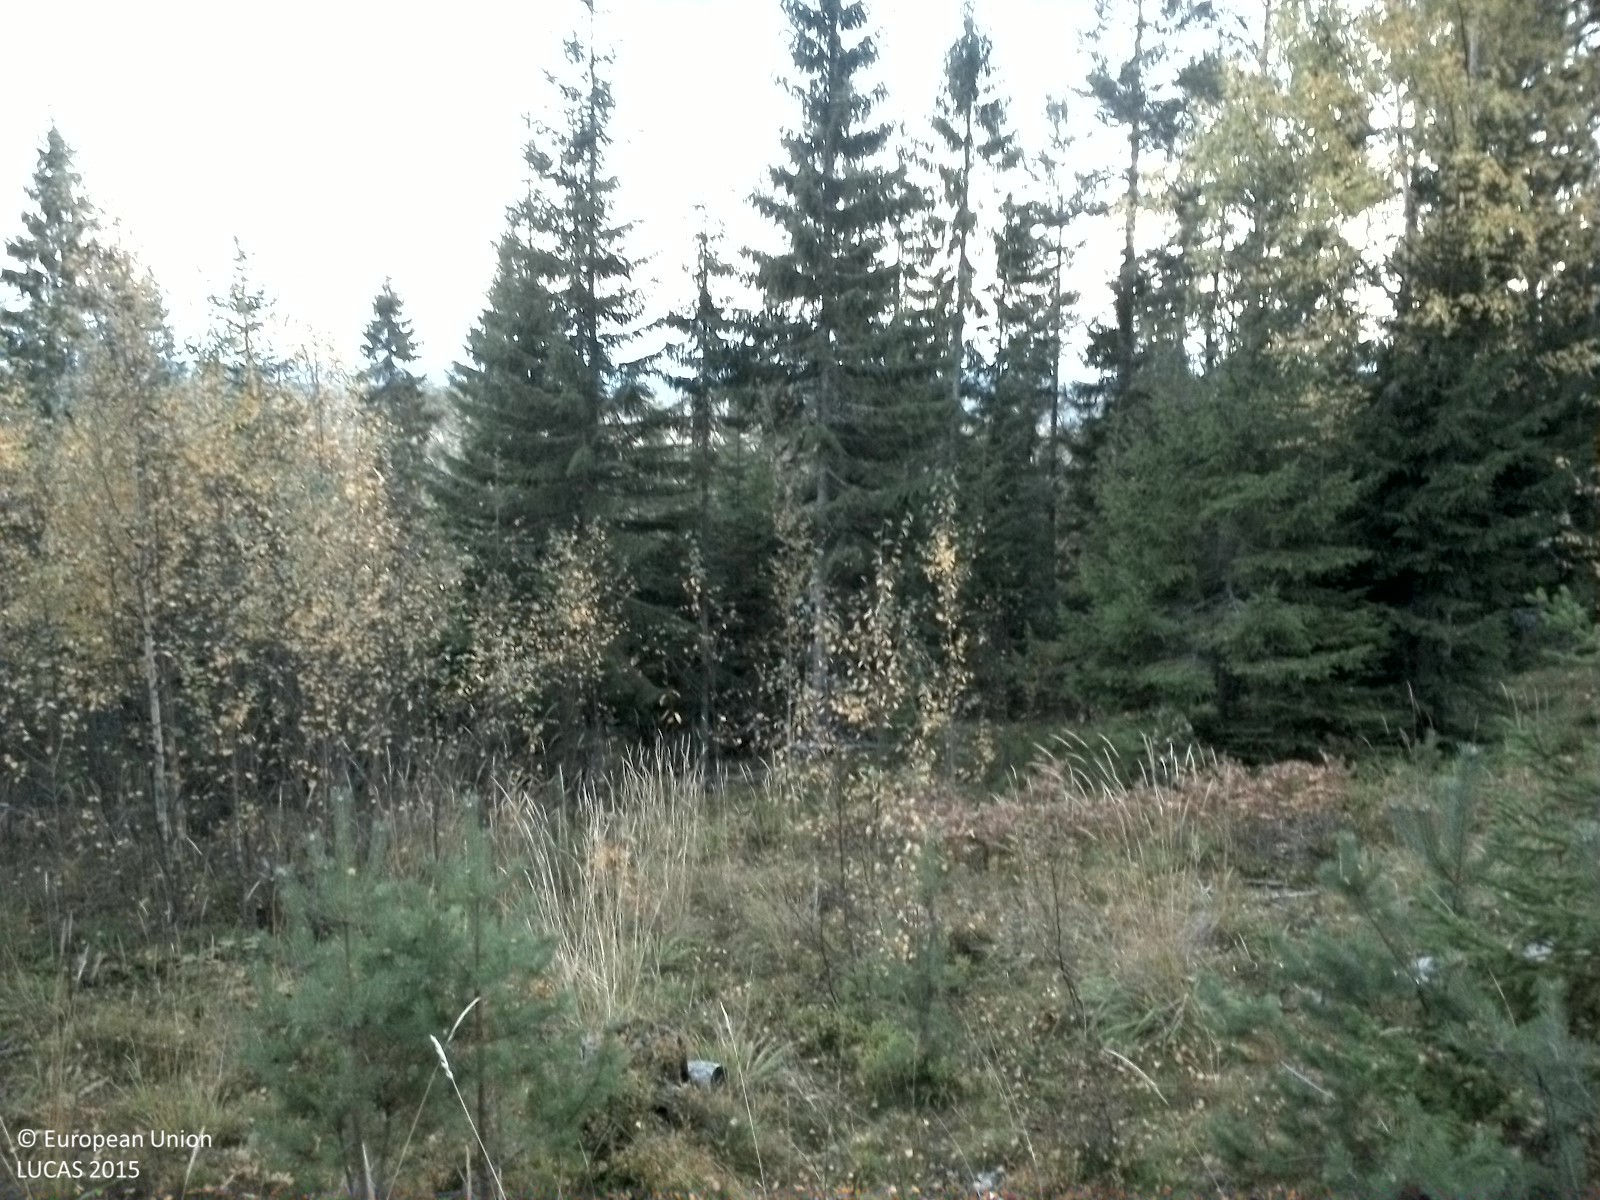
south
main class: Woodland
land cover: Spruce dominated mixed woodland
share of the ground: 50 - 75 %
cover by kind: coniferous forest trees 35 %, herbaceous plants 30 %, shrubs 20 %, broadleaved forest trees 15 %
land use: Forestry
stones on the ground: < 10 %
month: September
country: SE
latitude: 62.4471
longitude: 17.0529
